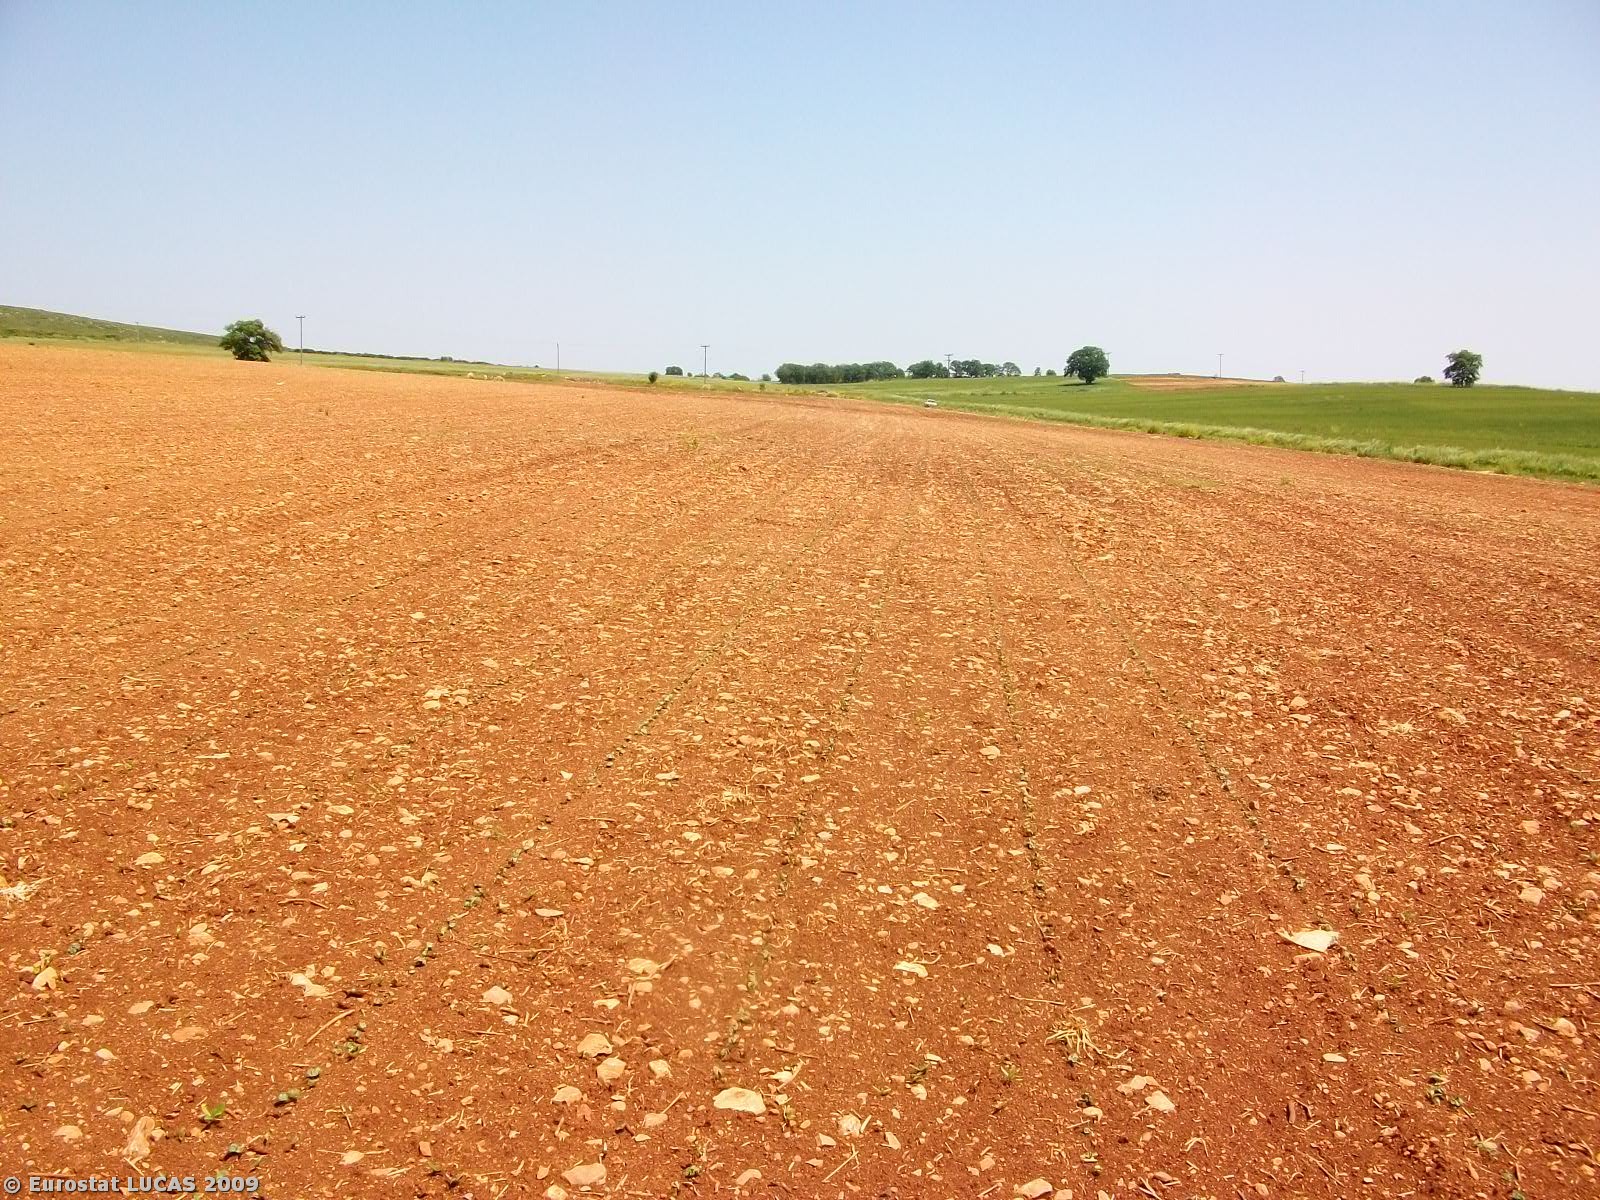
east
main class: Cropland
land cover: Cotton
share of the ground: < 10 %
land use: Agriculture (excluding fallow land and kitchen gardens)
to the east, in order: Cotton
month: May
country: GR
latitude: 39.2168
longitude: 22.5758
